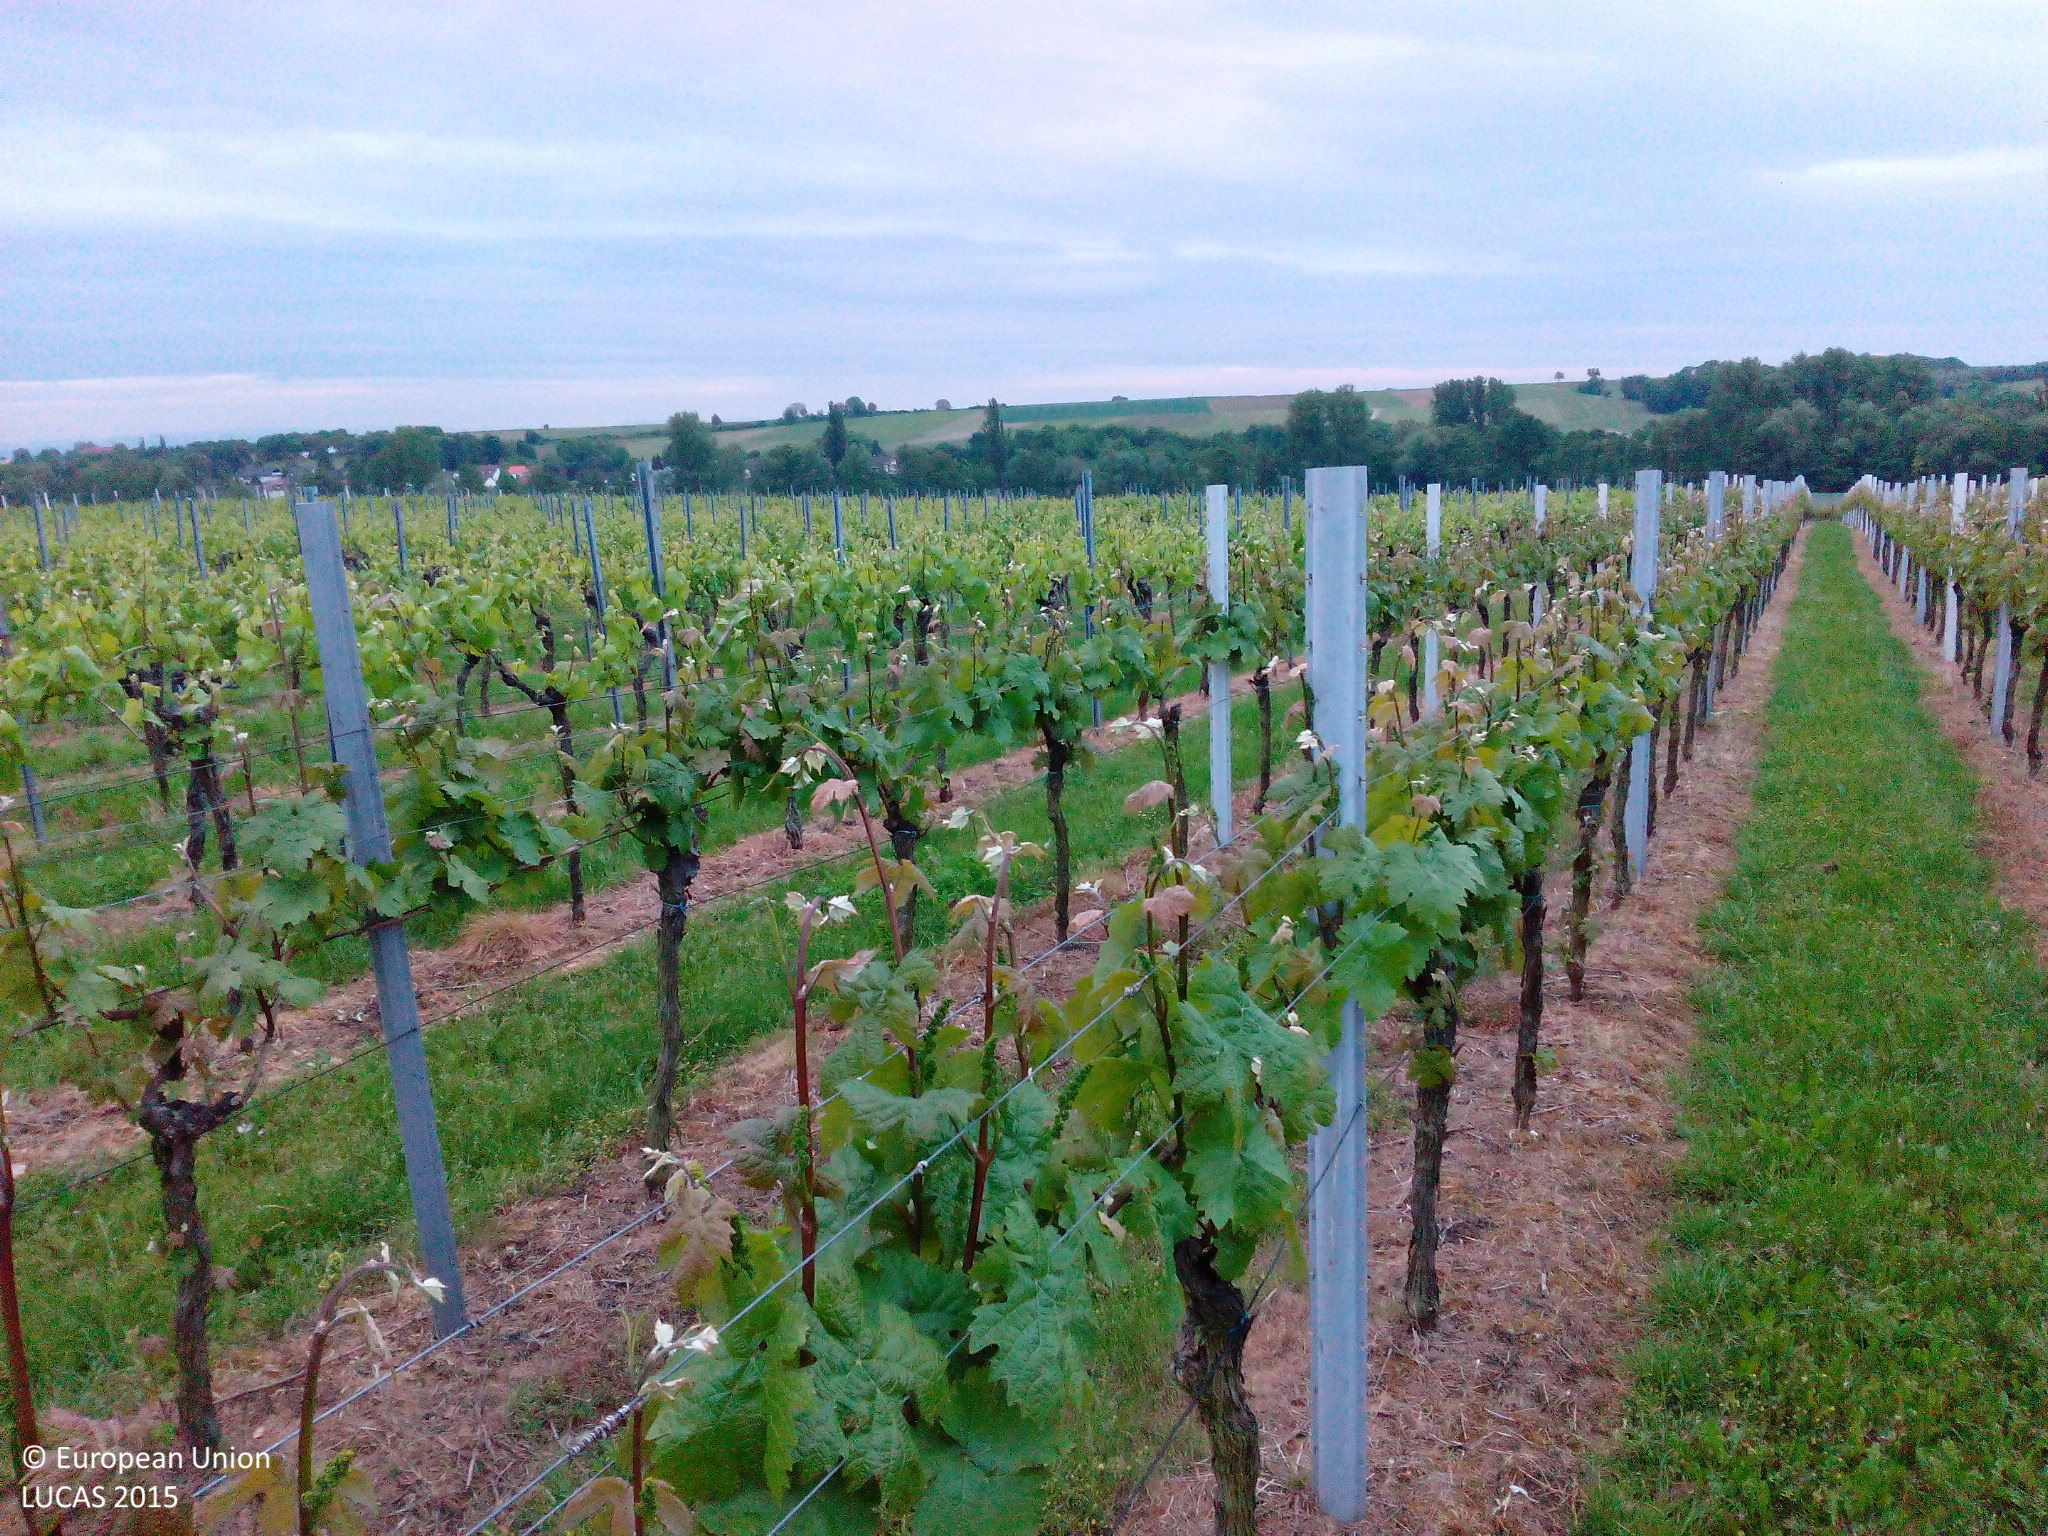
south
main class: Cropland
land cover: Vineyards
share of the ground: 25 - 50 %
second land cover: Grassland without tree/shrub cover
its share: 25 - 50 %
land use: Agriculture (excluding fallow land and kitchen gardens)
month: May
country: DE
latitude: 49.1424
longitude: 8.0678
